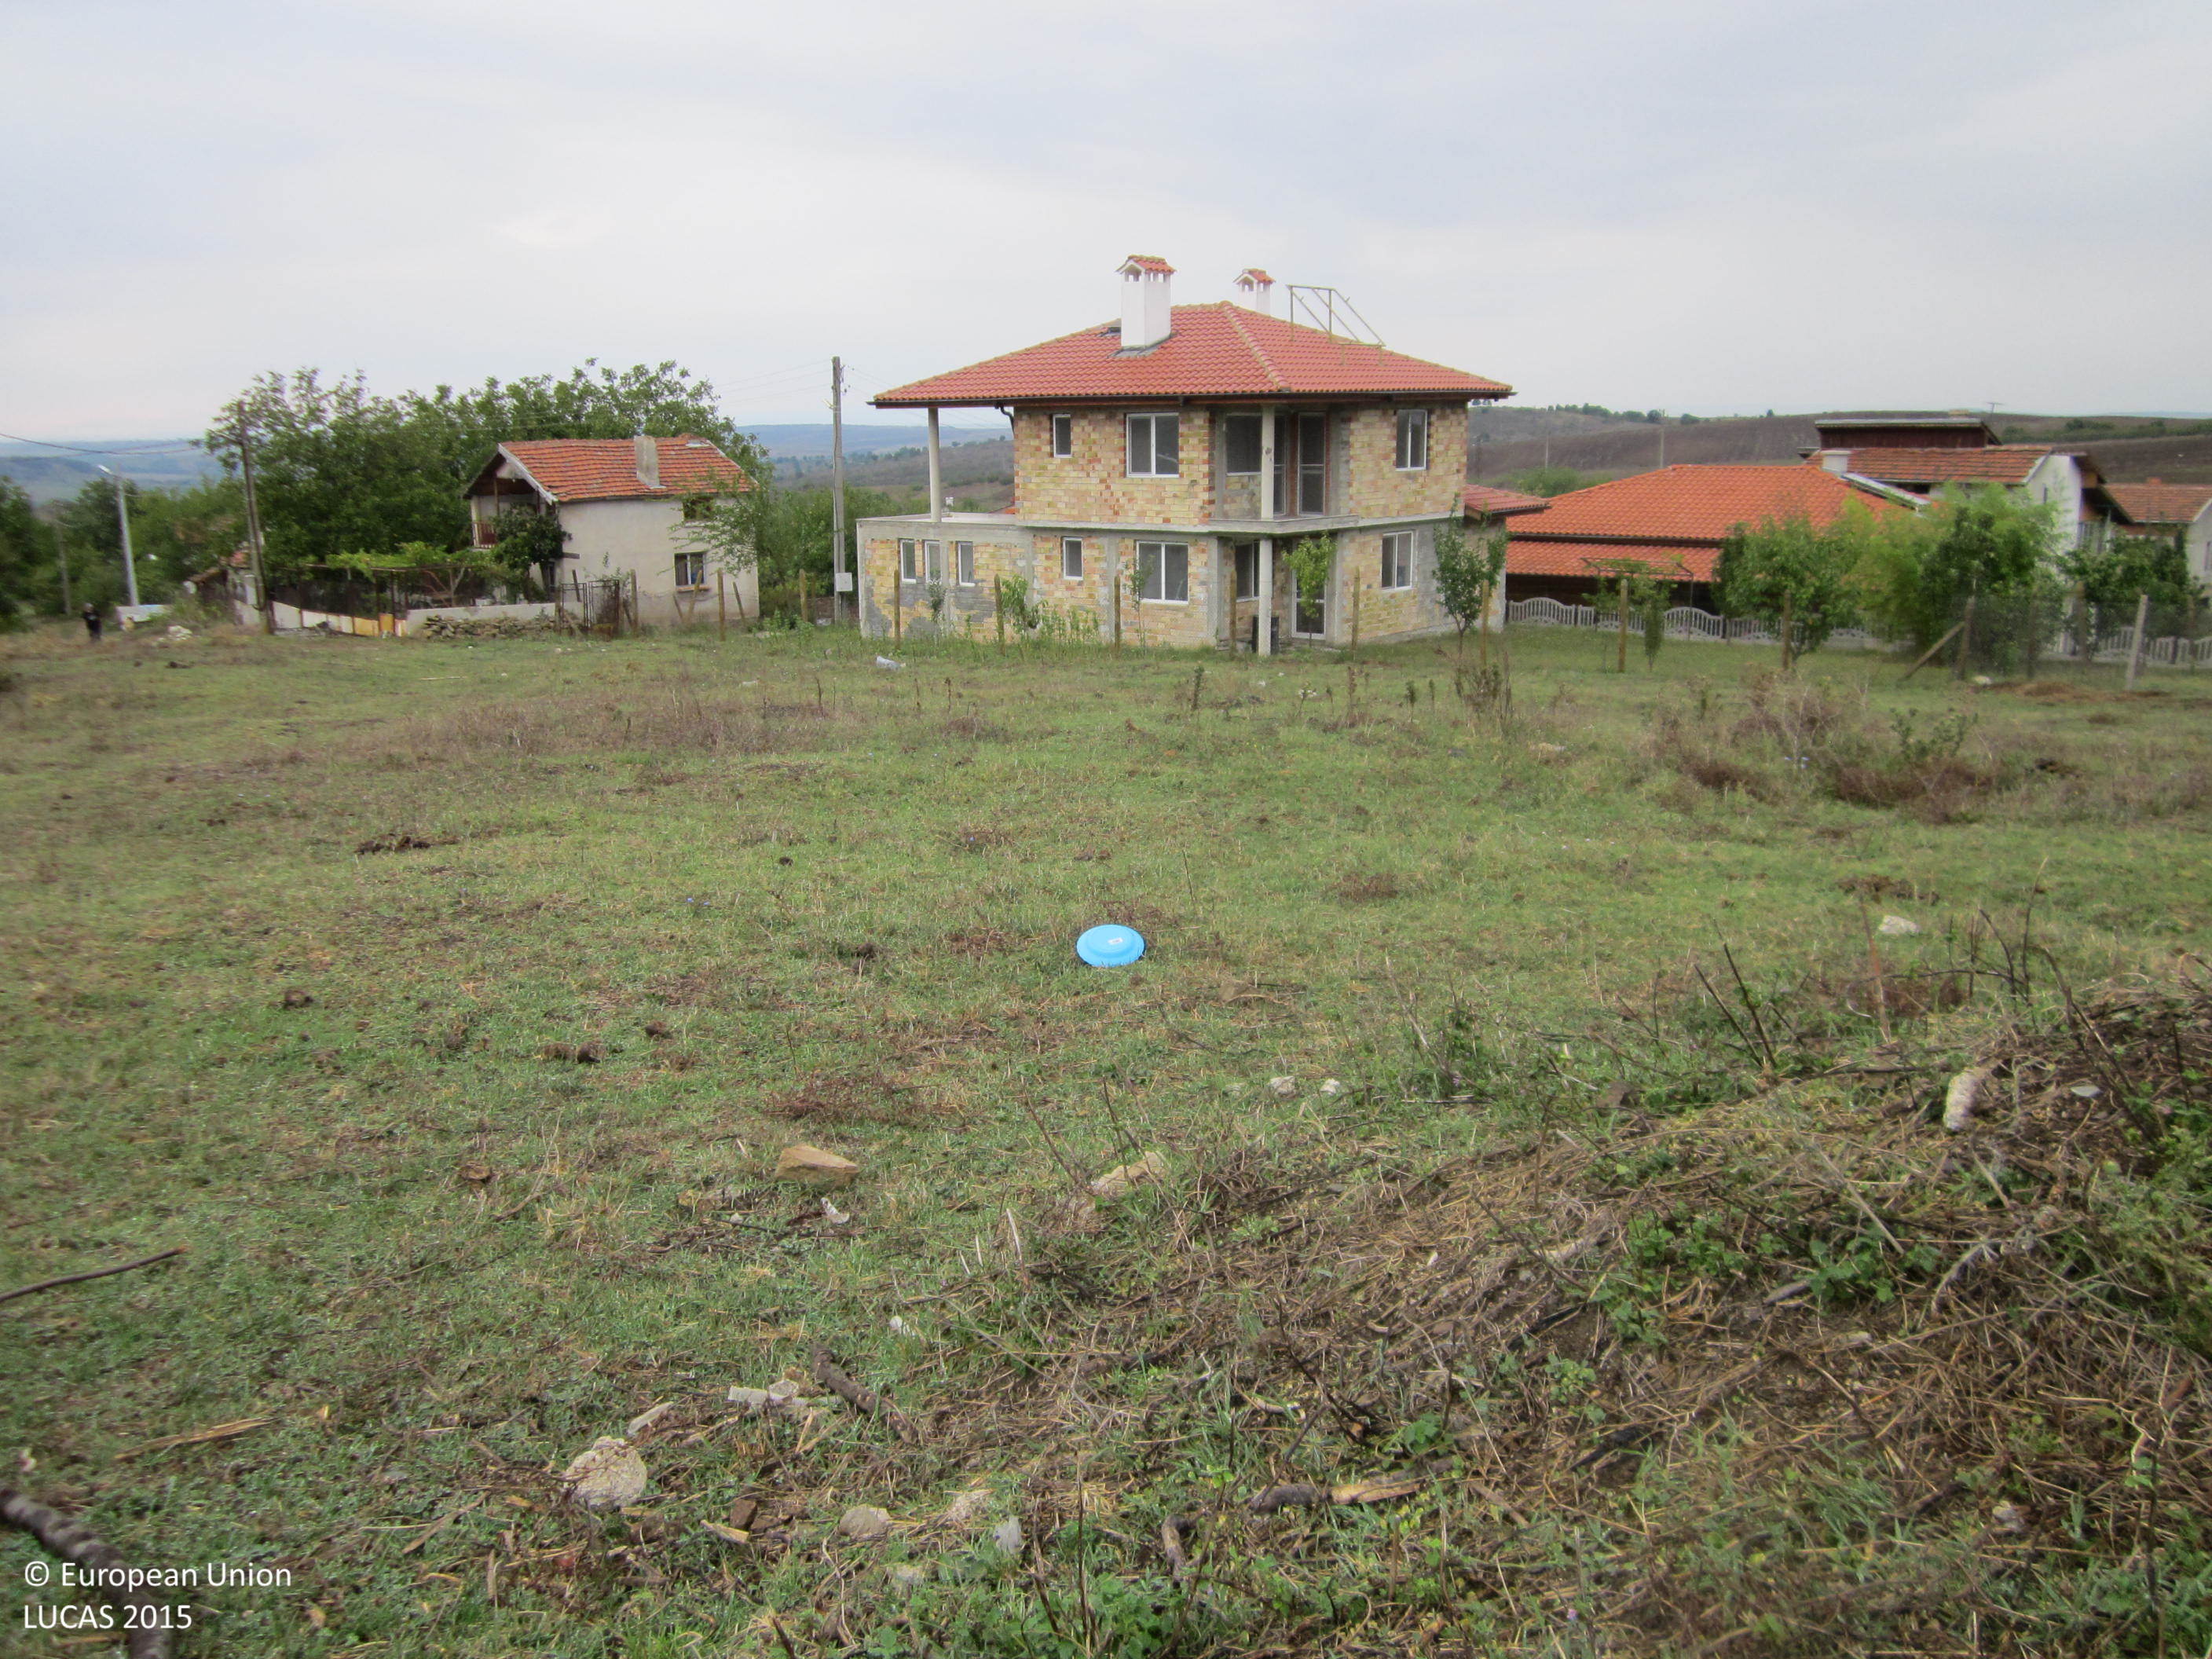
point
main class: Grassland
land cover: Grassland without tree/shrub cover
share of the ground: > 75 %
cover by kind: herbaceous plants 100 %
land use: Agriculture (excluding fallow land and kitchen gardens)
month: September
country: BG
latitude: 42.3384
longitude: 27.2592
